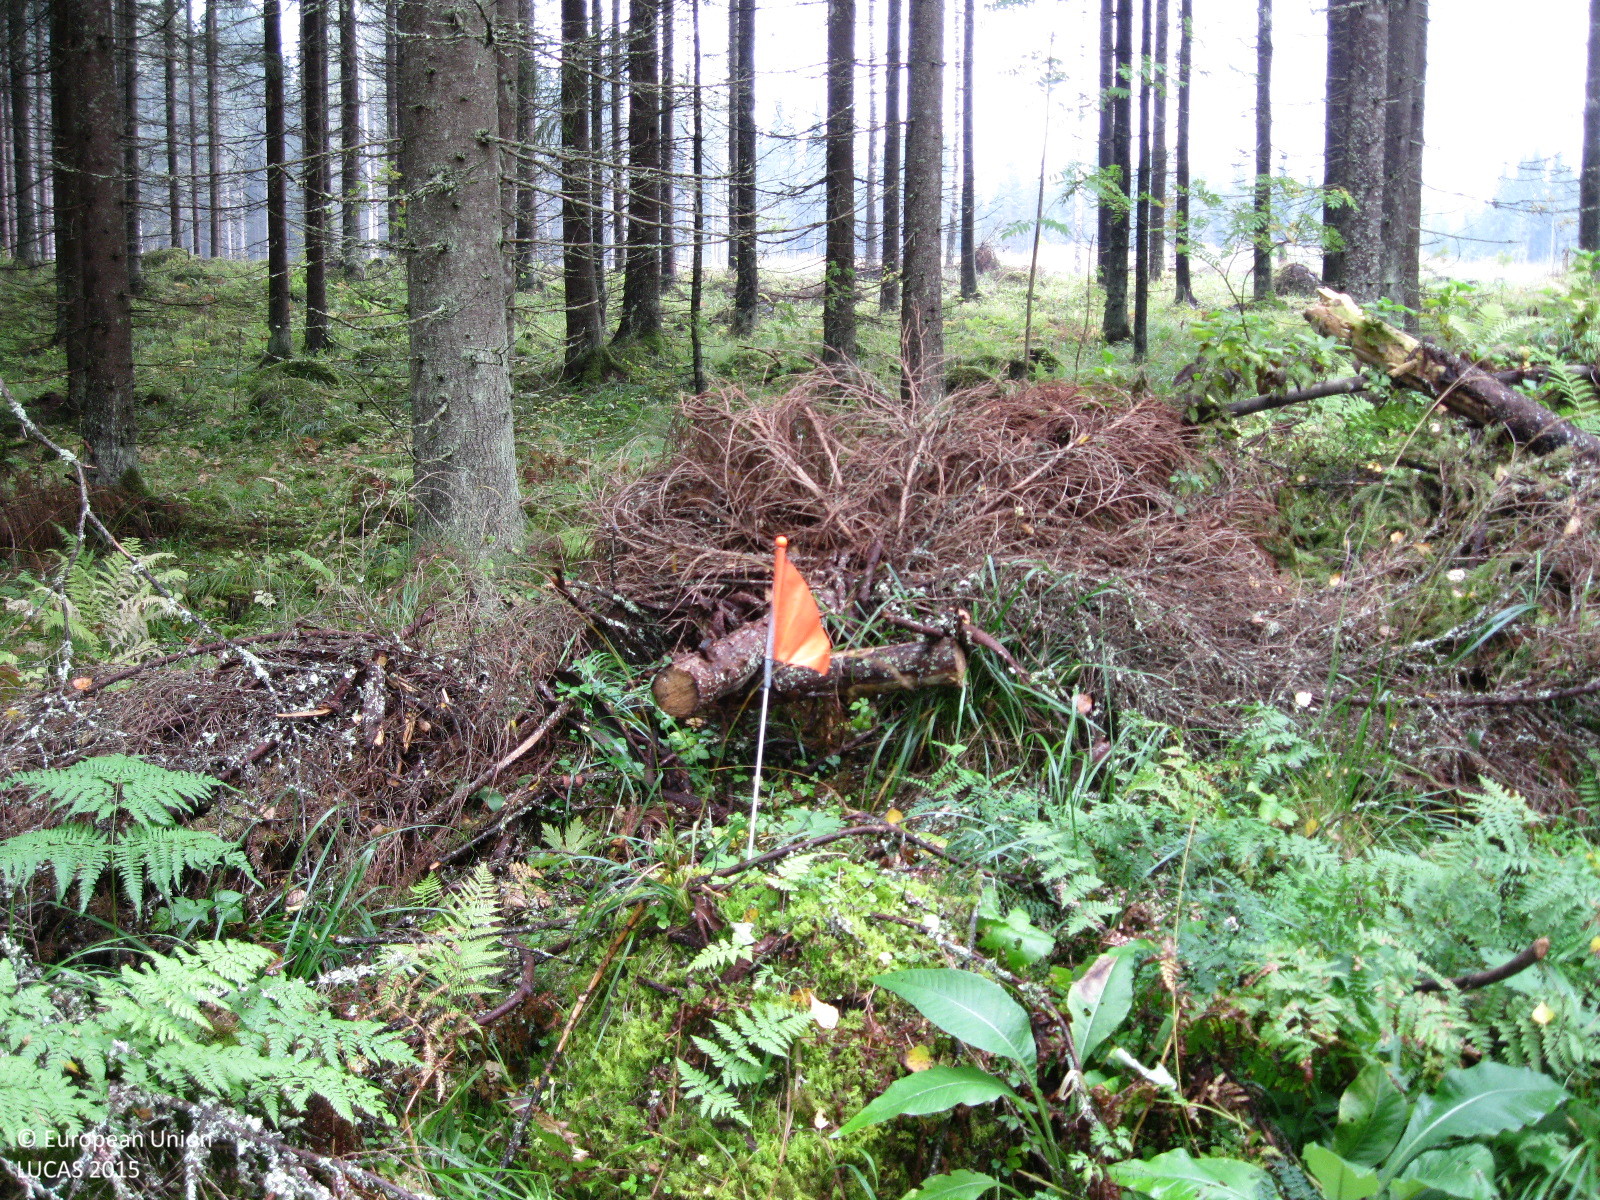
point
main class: Grassland
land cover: Spontaneously vegetated surfaces
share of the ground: > 75 %
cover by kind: herbaceous plants 100 %
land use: Forestry
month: September
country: FI
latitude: 60.9063
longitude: 24.9170
